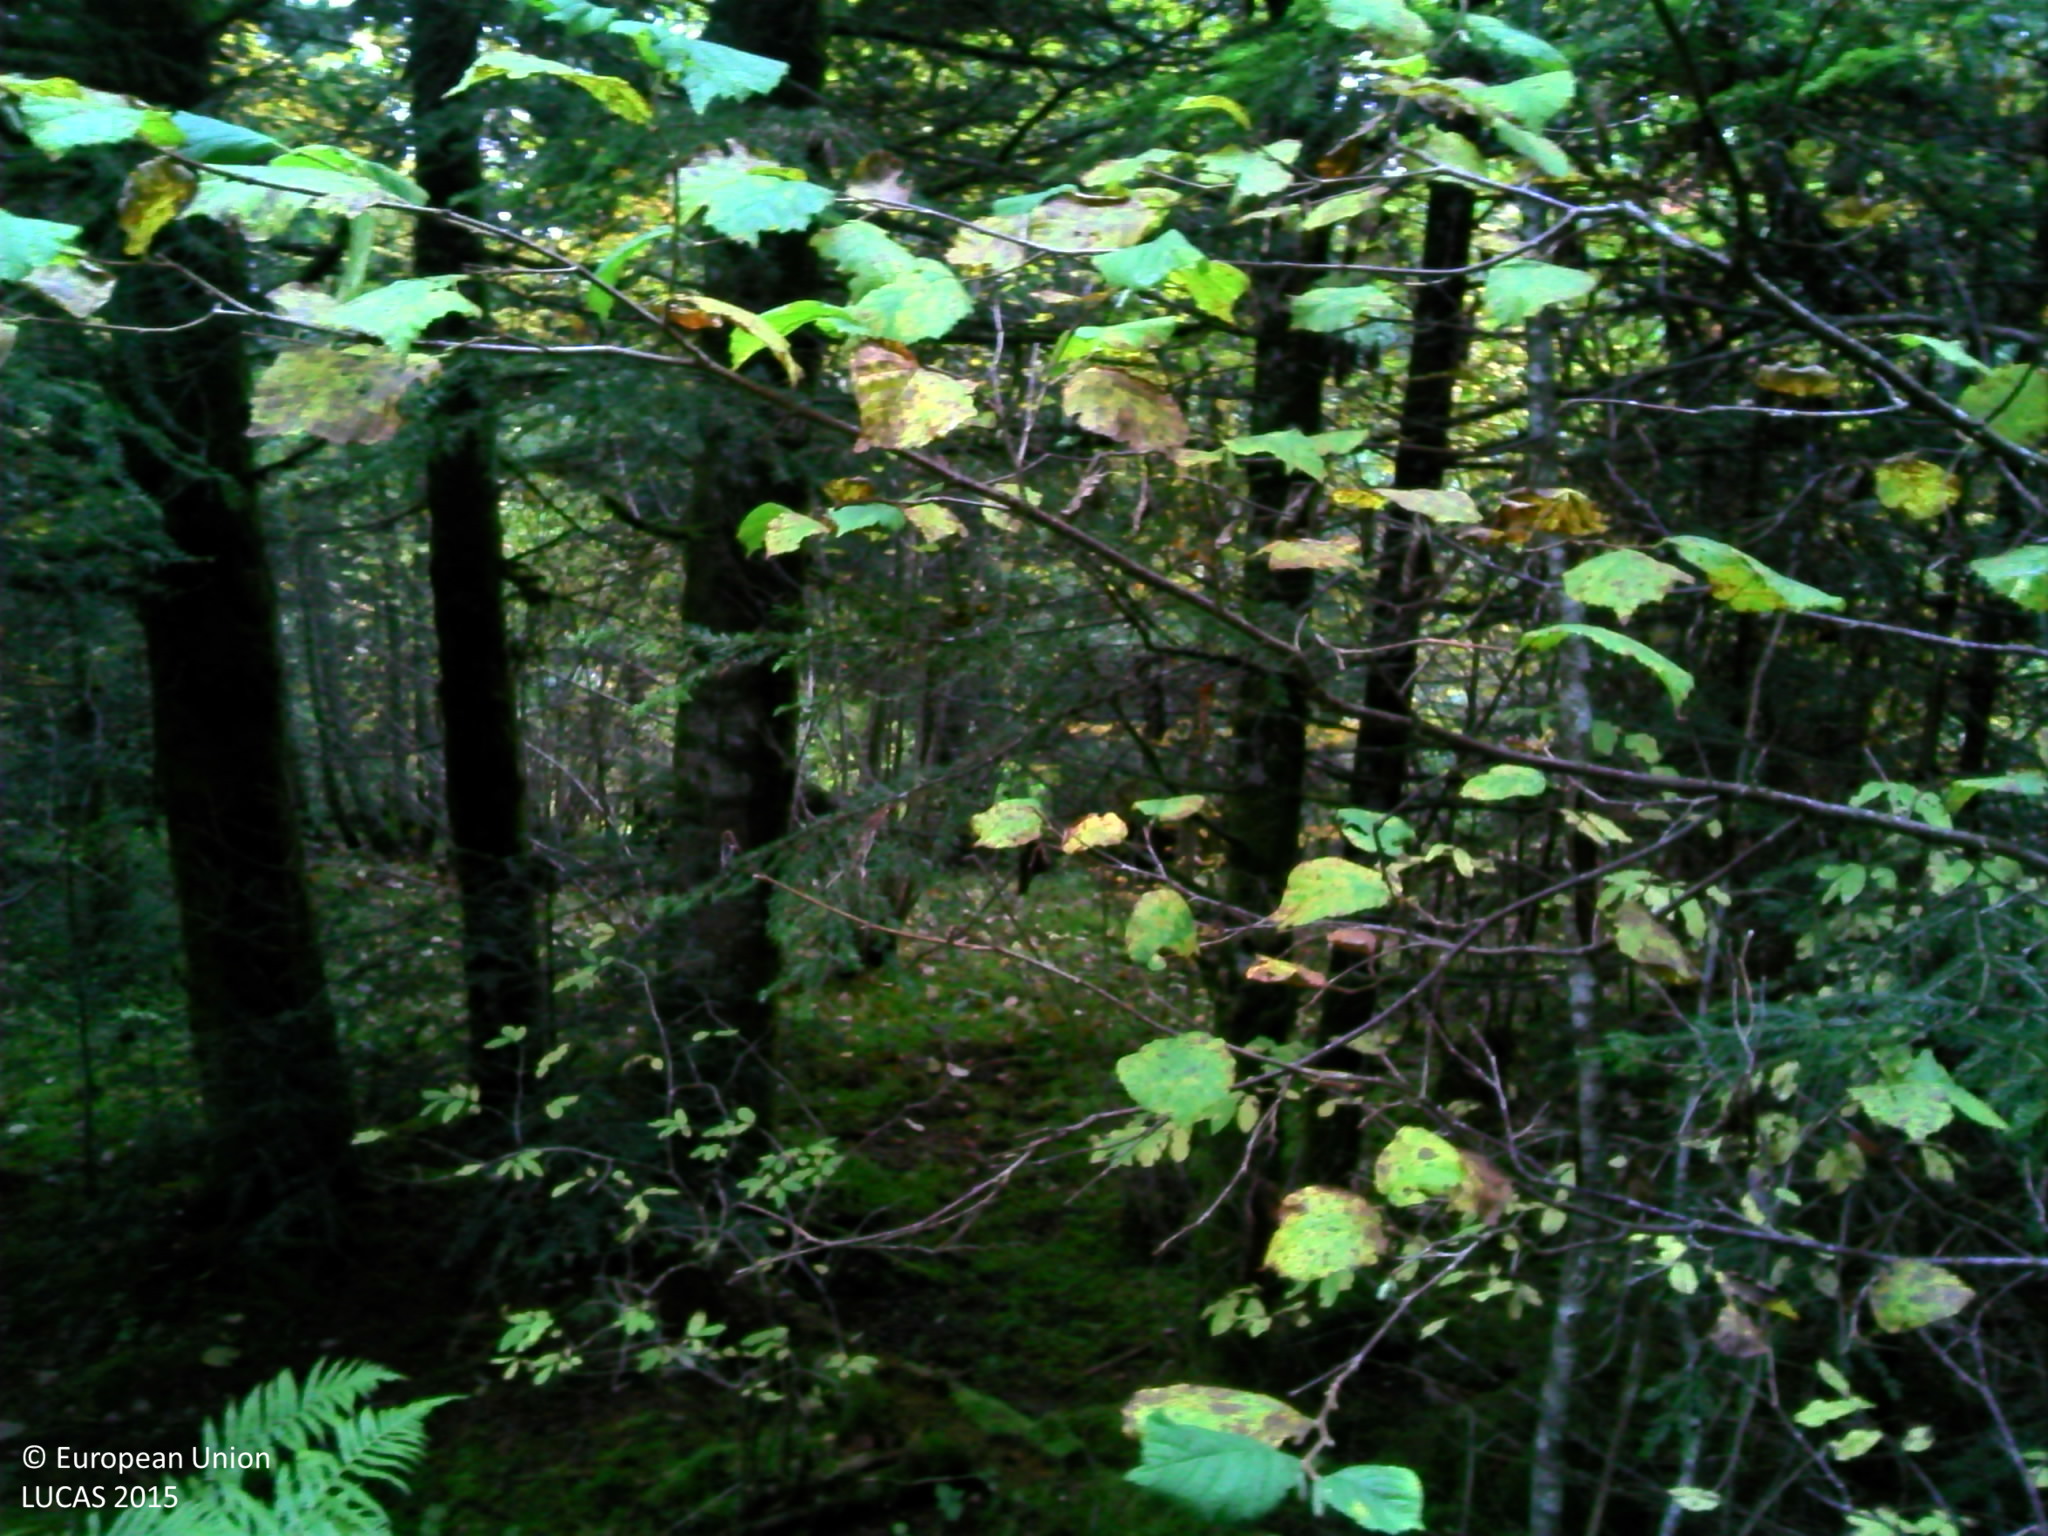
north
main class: Woodland
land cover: Spruce dominated mixed woodland
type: hemiboreal forest and nemoral coniferous forest and mixed broadleaved-coniferous forest
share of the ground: > 75 %
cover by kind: coniferous forest trees 40 %, broadleaved forest trees 40 %, shrubs 20 %
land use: Forestry
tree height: > 5 m
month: October
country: FR
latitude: 46.7927
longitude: 6.3213
